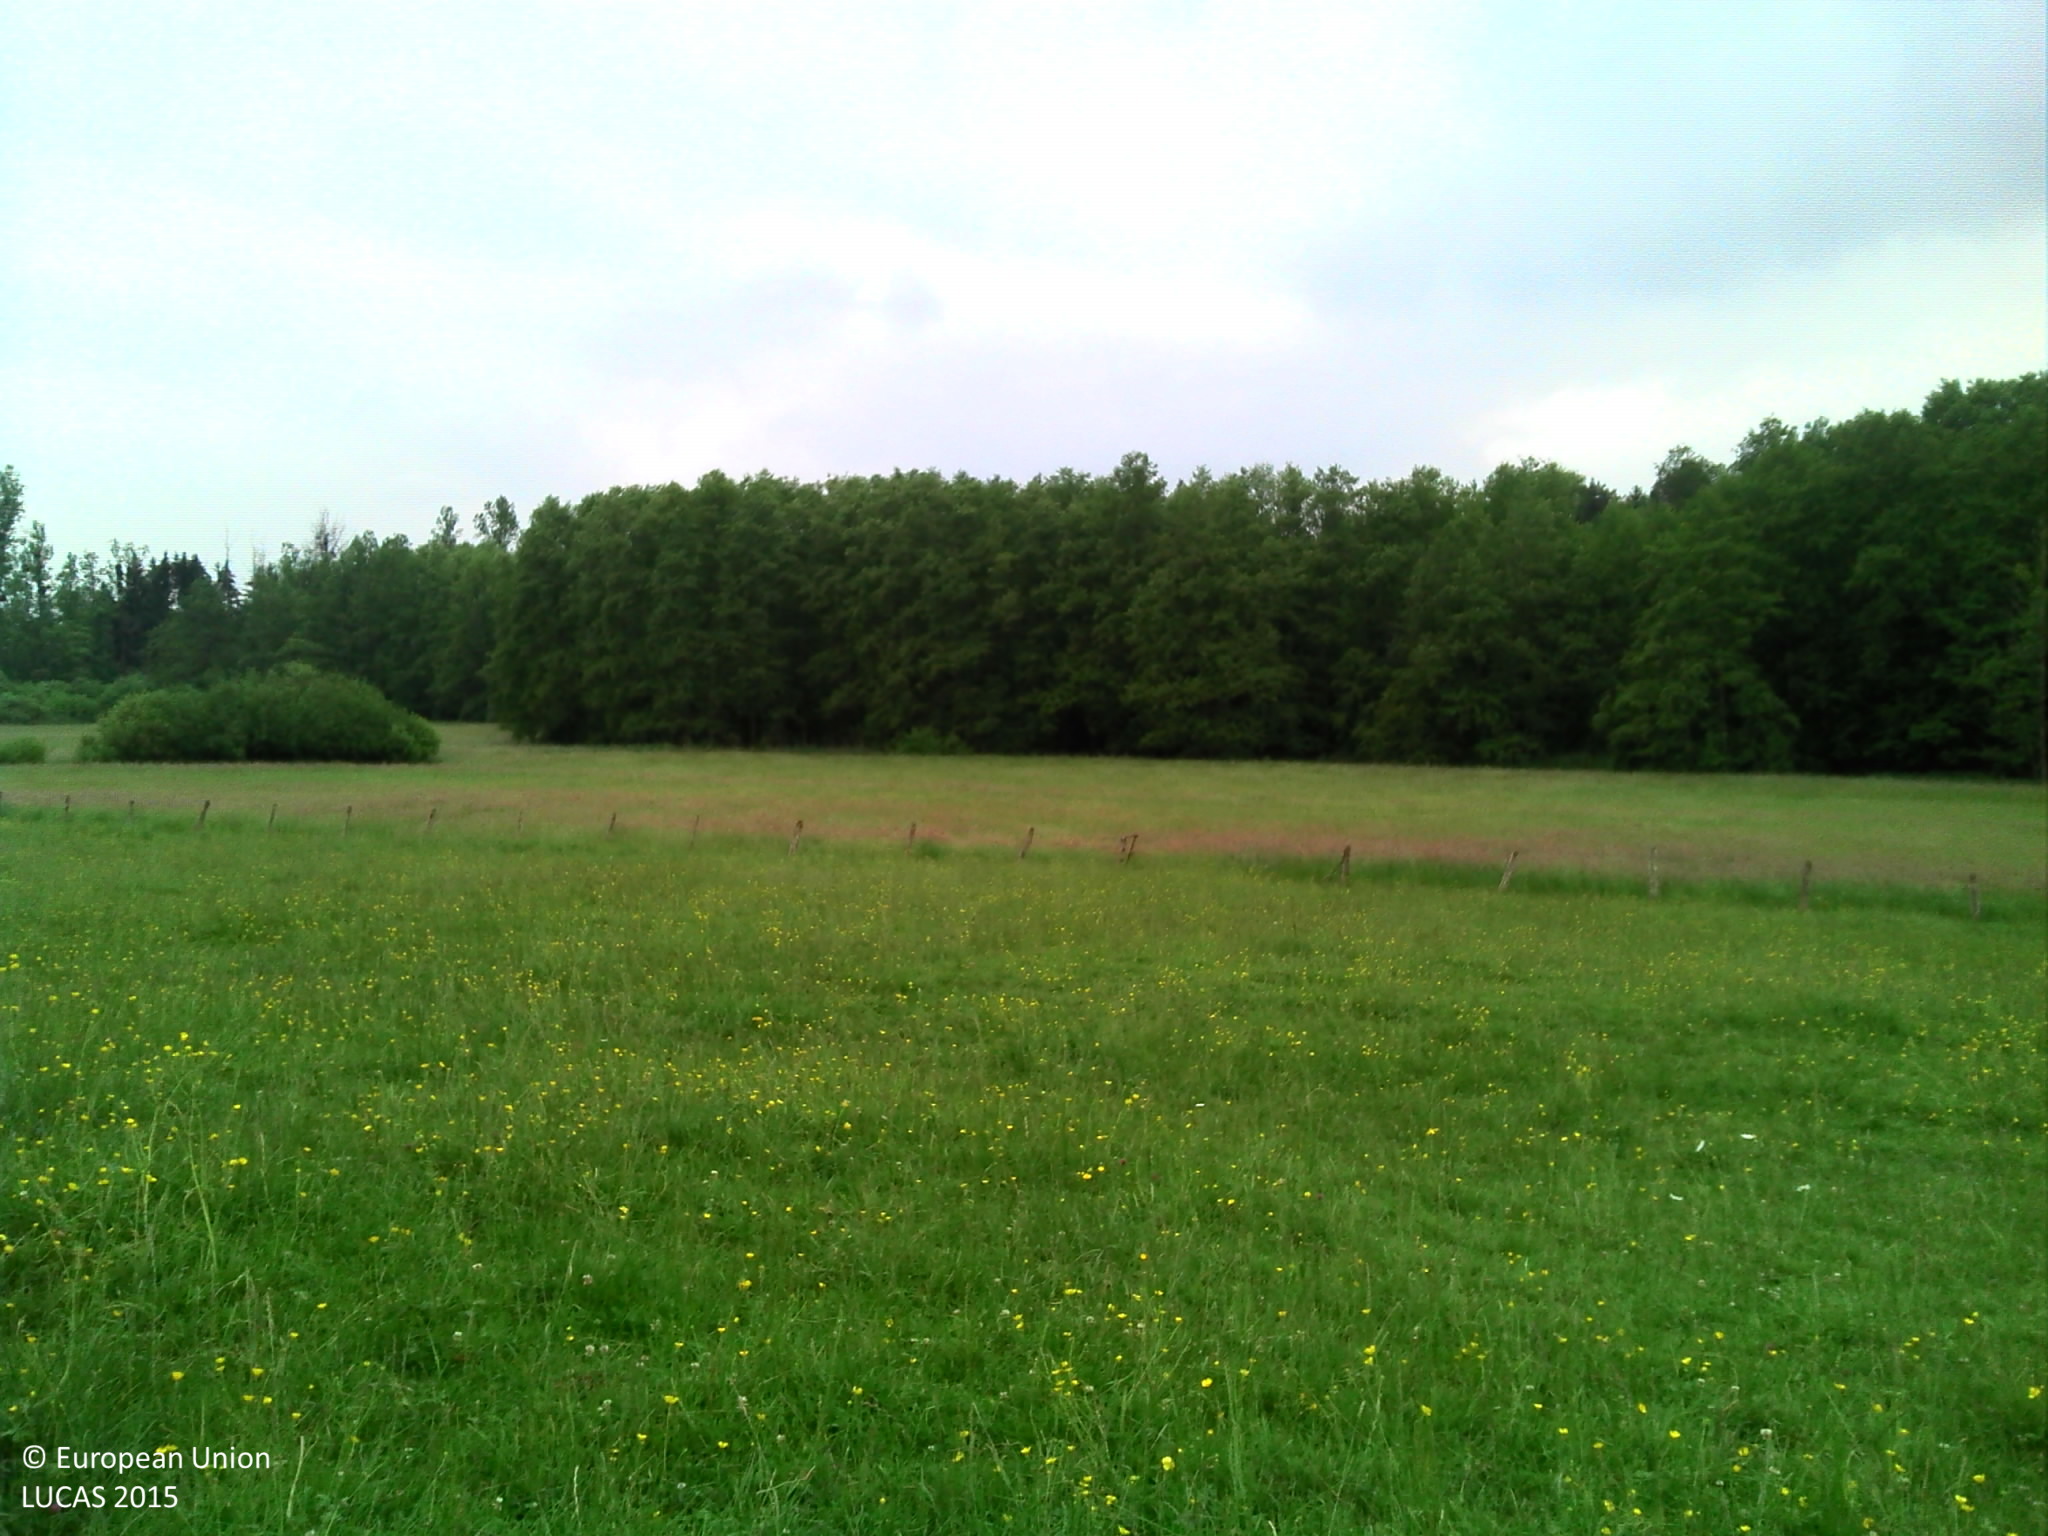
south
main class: Grassland
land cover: Grassland without tree/shrub cover
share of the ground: > 75 %
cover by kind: herbaceous plants 100 %
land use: Agriculture (excluding fallow land and kitchen gardens)
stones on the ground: < 10 %
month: May
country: FR
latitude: 47.9064
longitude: 6.2148
